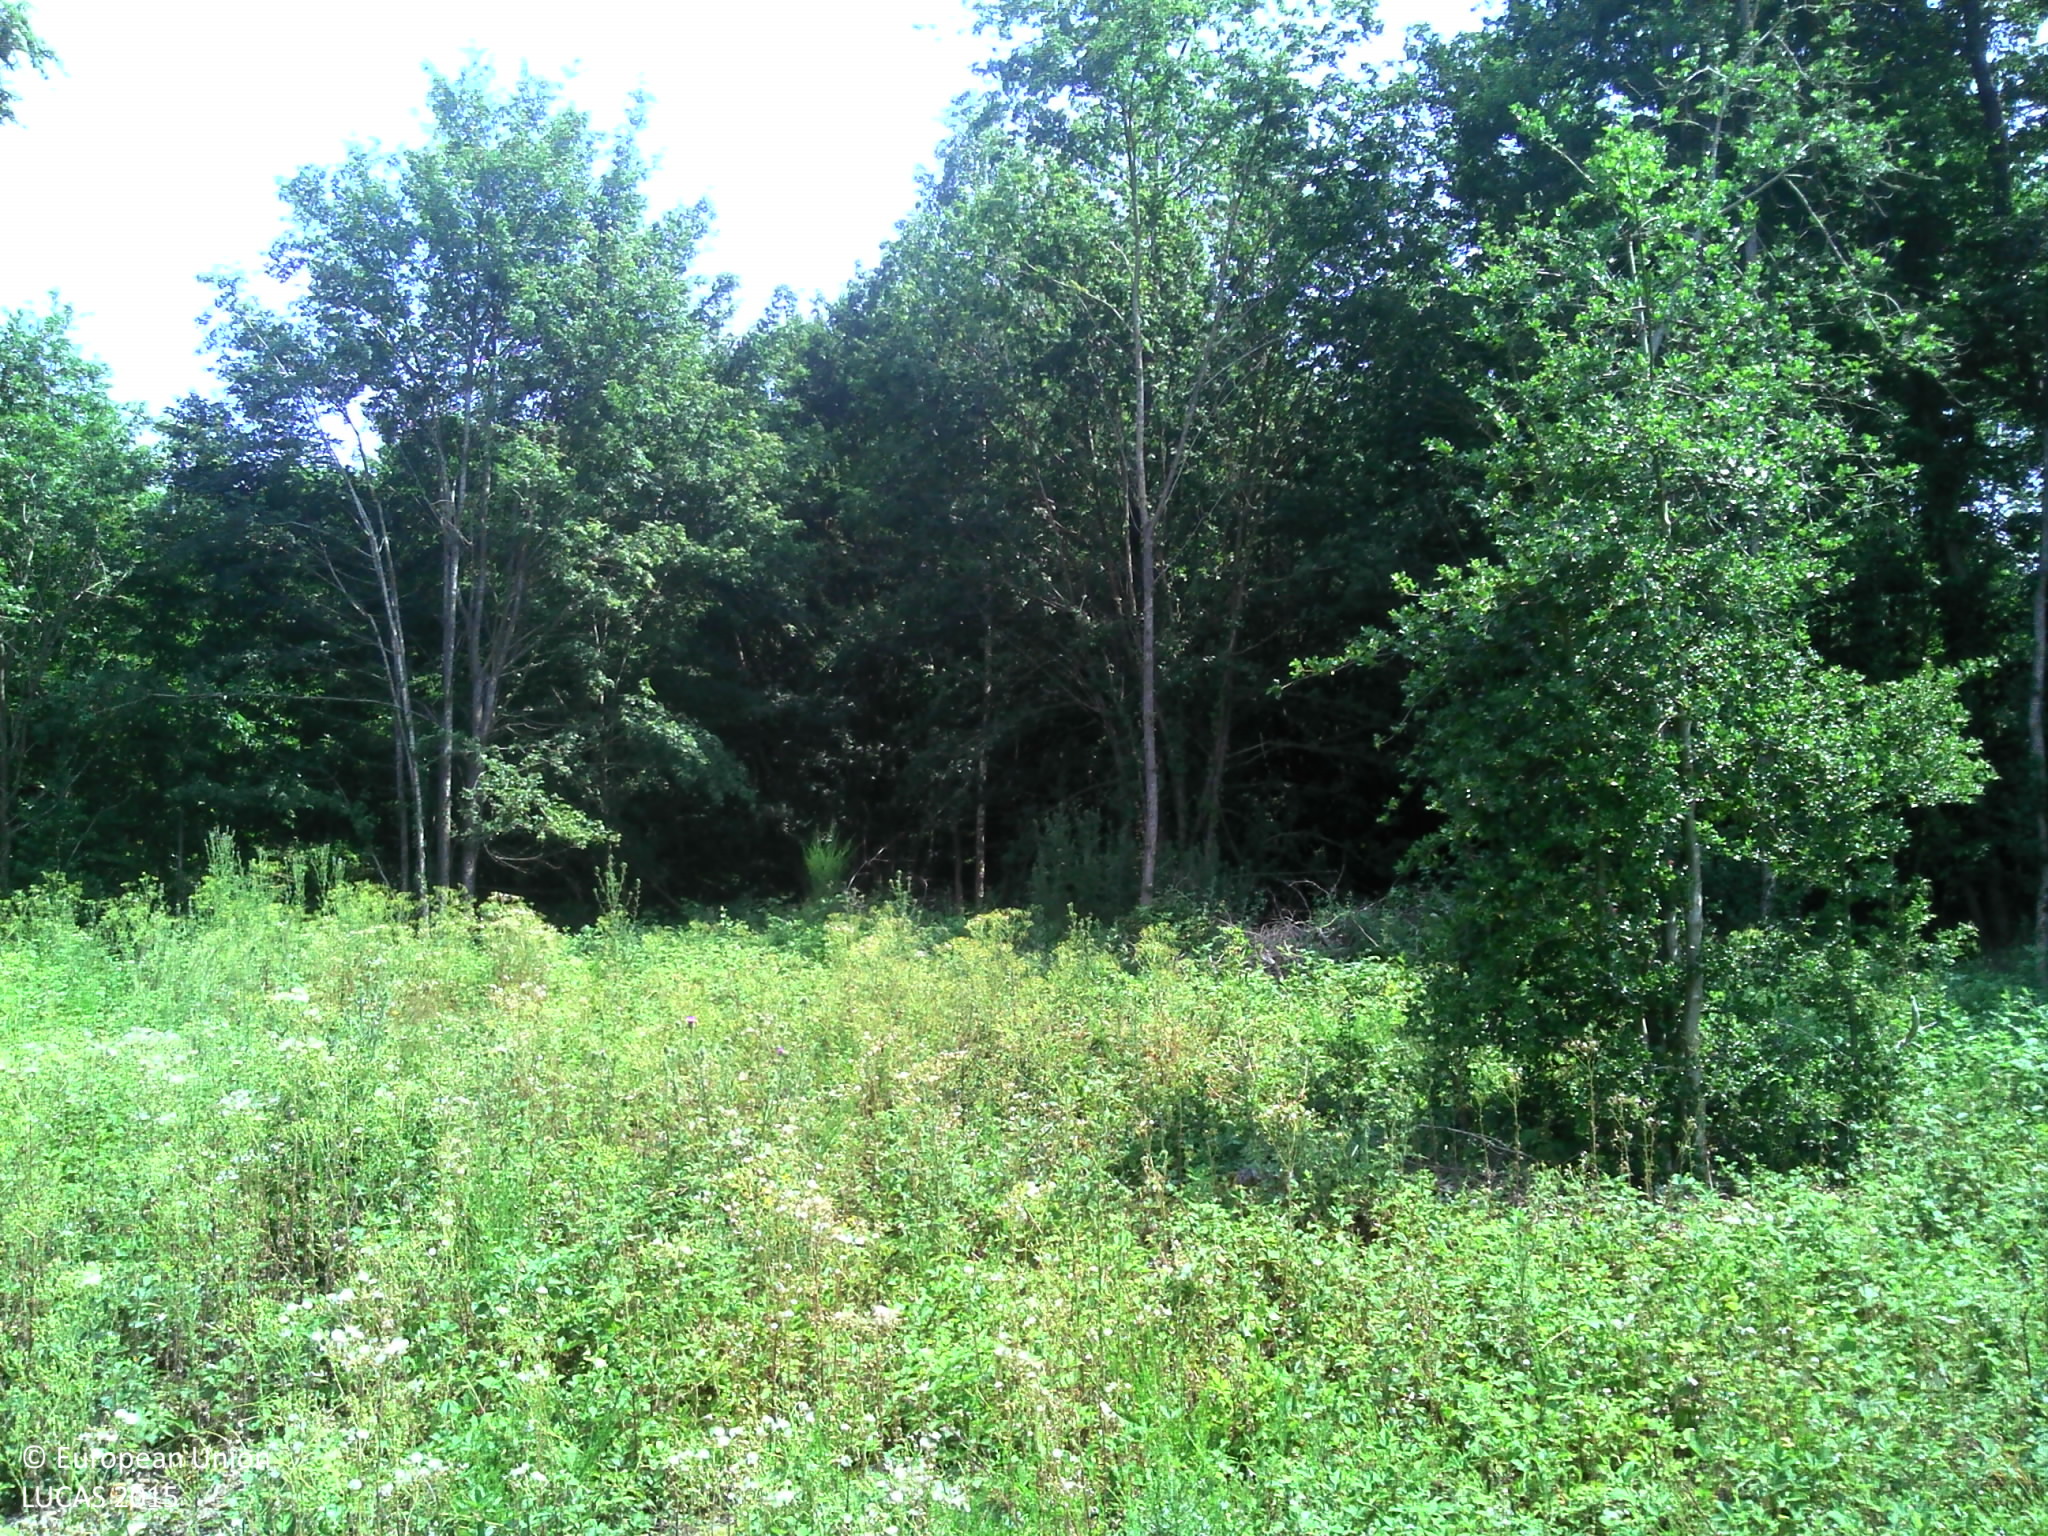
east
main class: Shrubland
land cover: Shrubland without tree cover
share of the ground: > 75 %
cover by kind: herbaceous plants 60 %, shrubs 40 %
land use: Forestry
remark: Clear cut
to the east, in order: Shrubland without tree cover; Broadleaved woodland
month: July
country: FR
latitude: 48.8119
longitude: 1.1970
